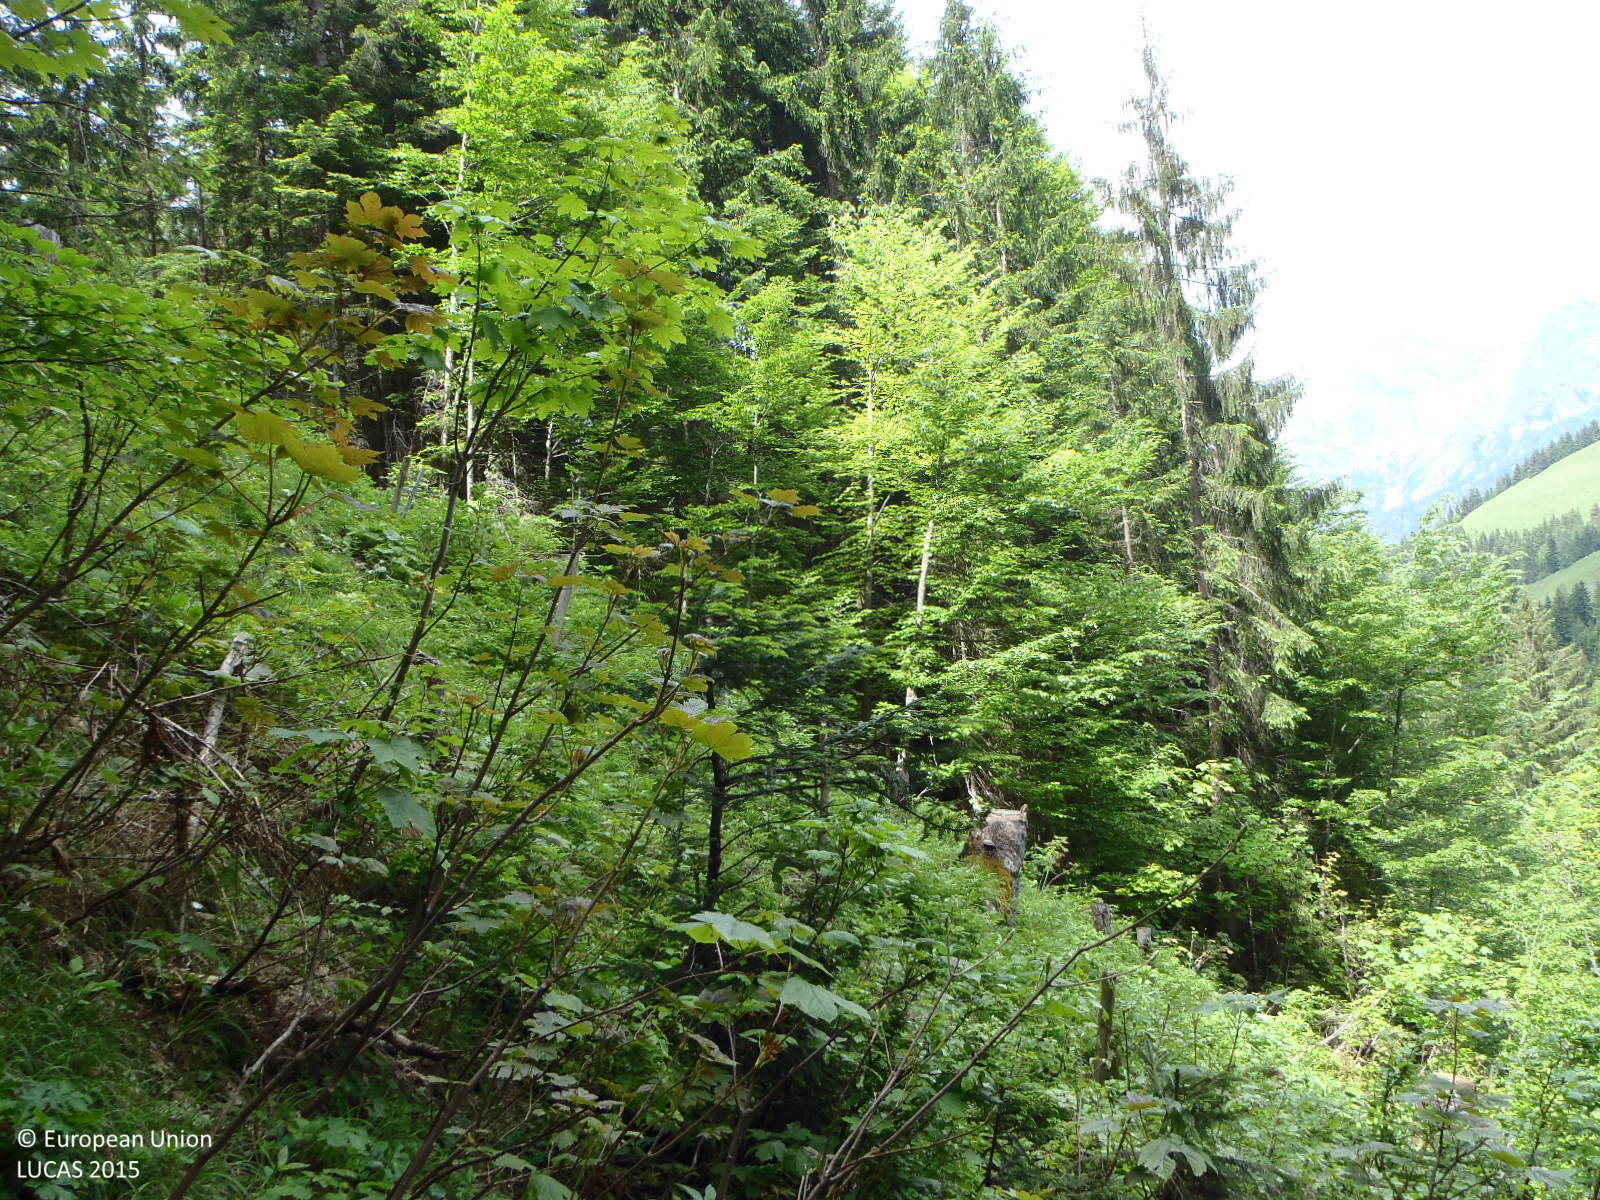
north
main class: Woodland
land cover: Broadleaved woodland
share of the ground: > 75 %
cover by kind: broadleaved forest trees 60 %, coniferous forest trees 10 %, shrubs 10 %, herbaceous plants 10 %, lichens and mosses 10 %
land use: Forestry
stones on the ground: < 10 %
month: June
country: AT
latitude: 47.4909
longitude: 12.5865
